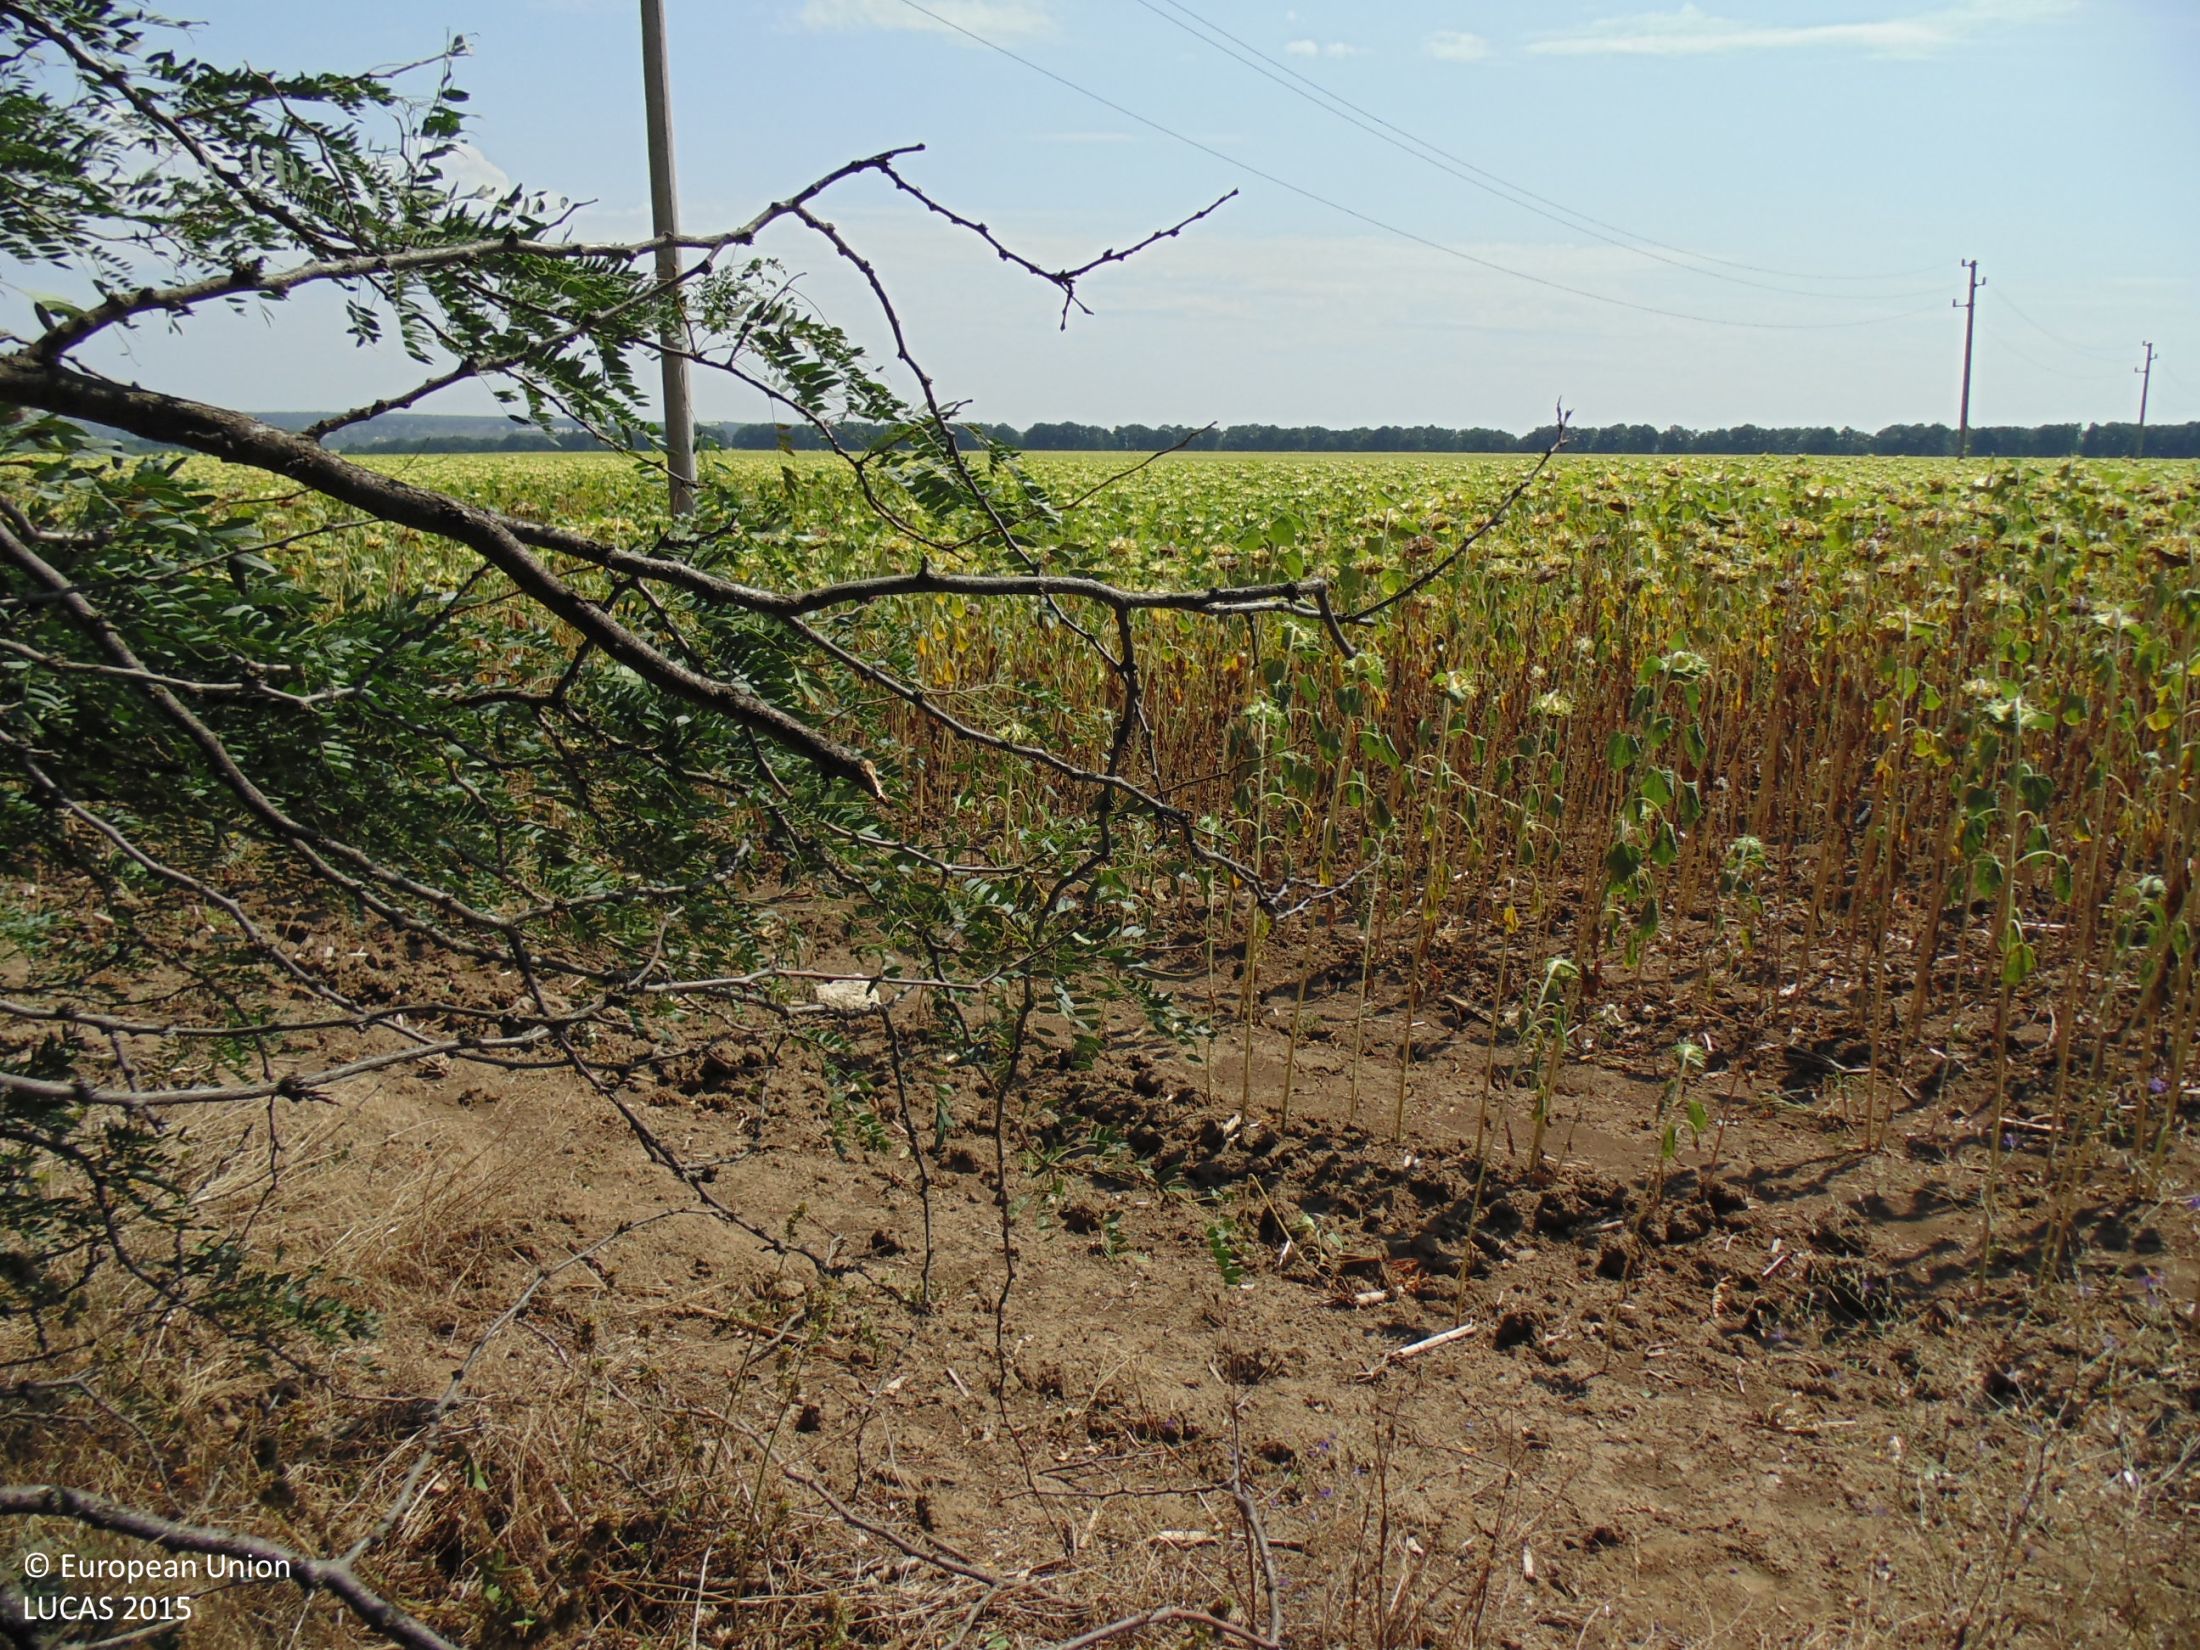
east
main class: Woodland
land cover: Broadleaved woodland
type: mesophytic deciduous forest
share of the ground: > 75 %
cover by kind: broadleaved forest trees 90 %, shrubs 5 %, unconsolidated bare surface 5 %
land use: Forestry
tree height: > 5 m
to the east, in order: Broadleaved woodland; Grass margins; Sunflower; Electric lines; Sunflower
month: August
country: BG
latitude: 43.7469
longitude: 27.6352
